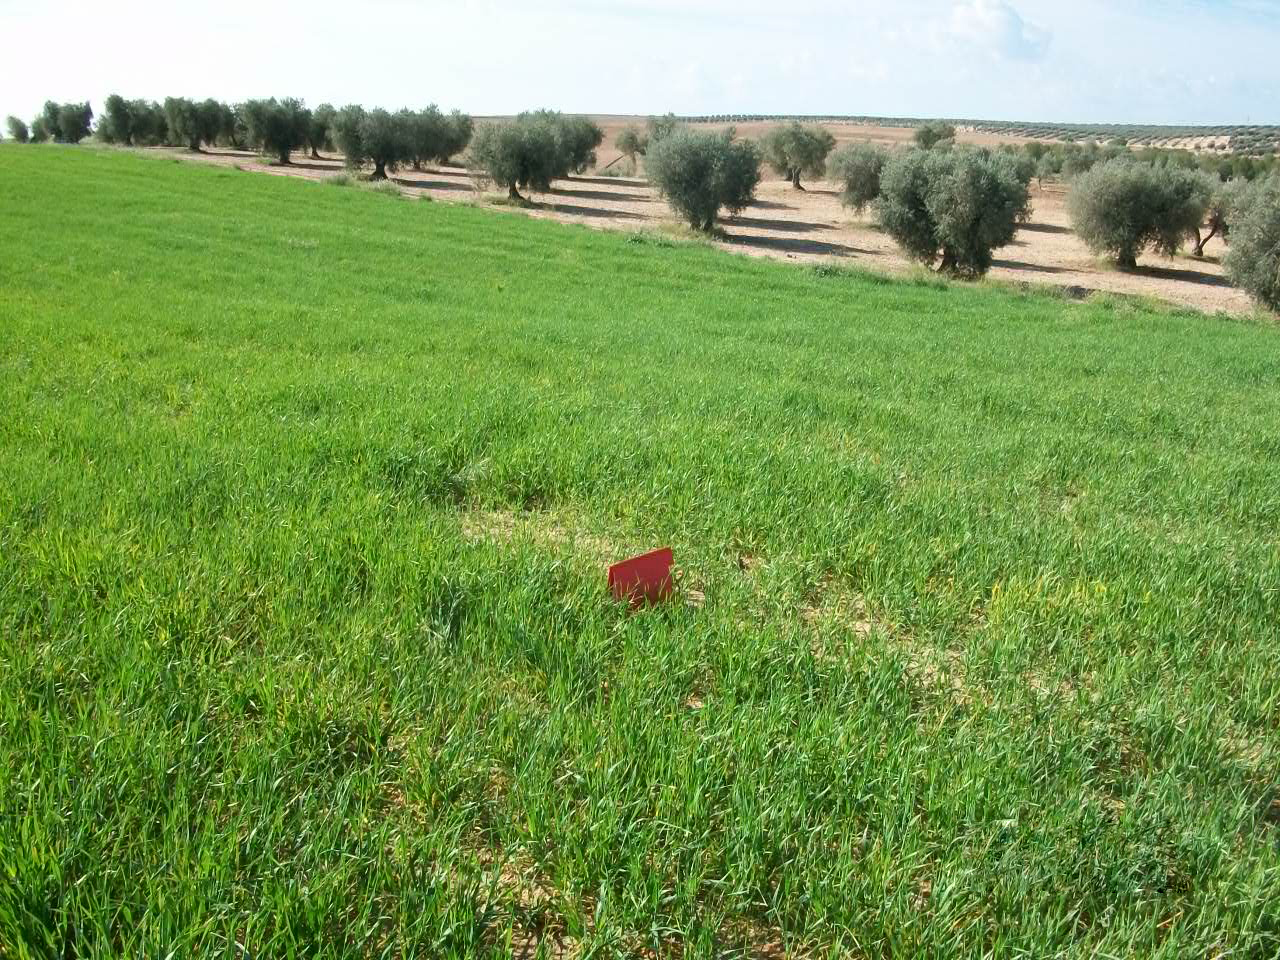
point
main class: Cropland
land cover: Barley
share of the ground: > 75 %
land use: Agriculture (excluding fallow land and kitchen gardens)
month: April
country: ES
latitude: 39.8777
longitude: -3.7698
